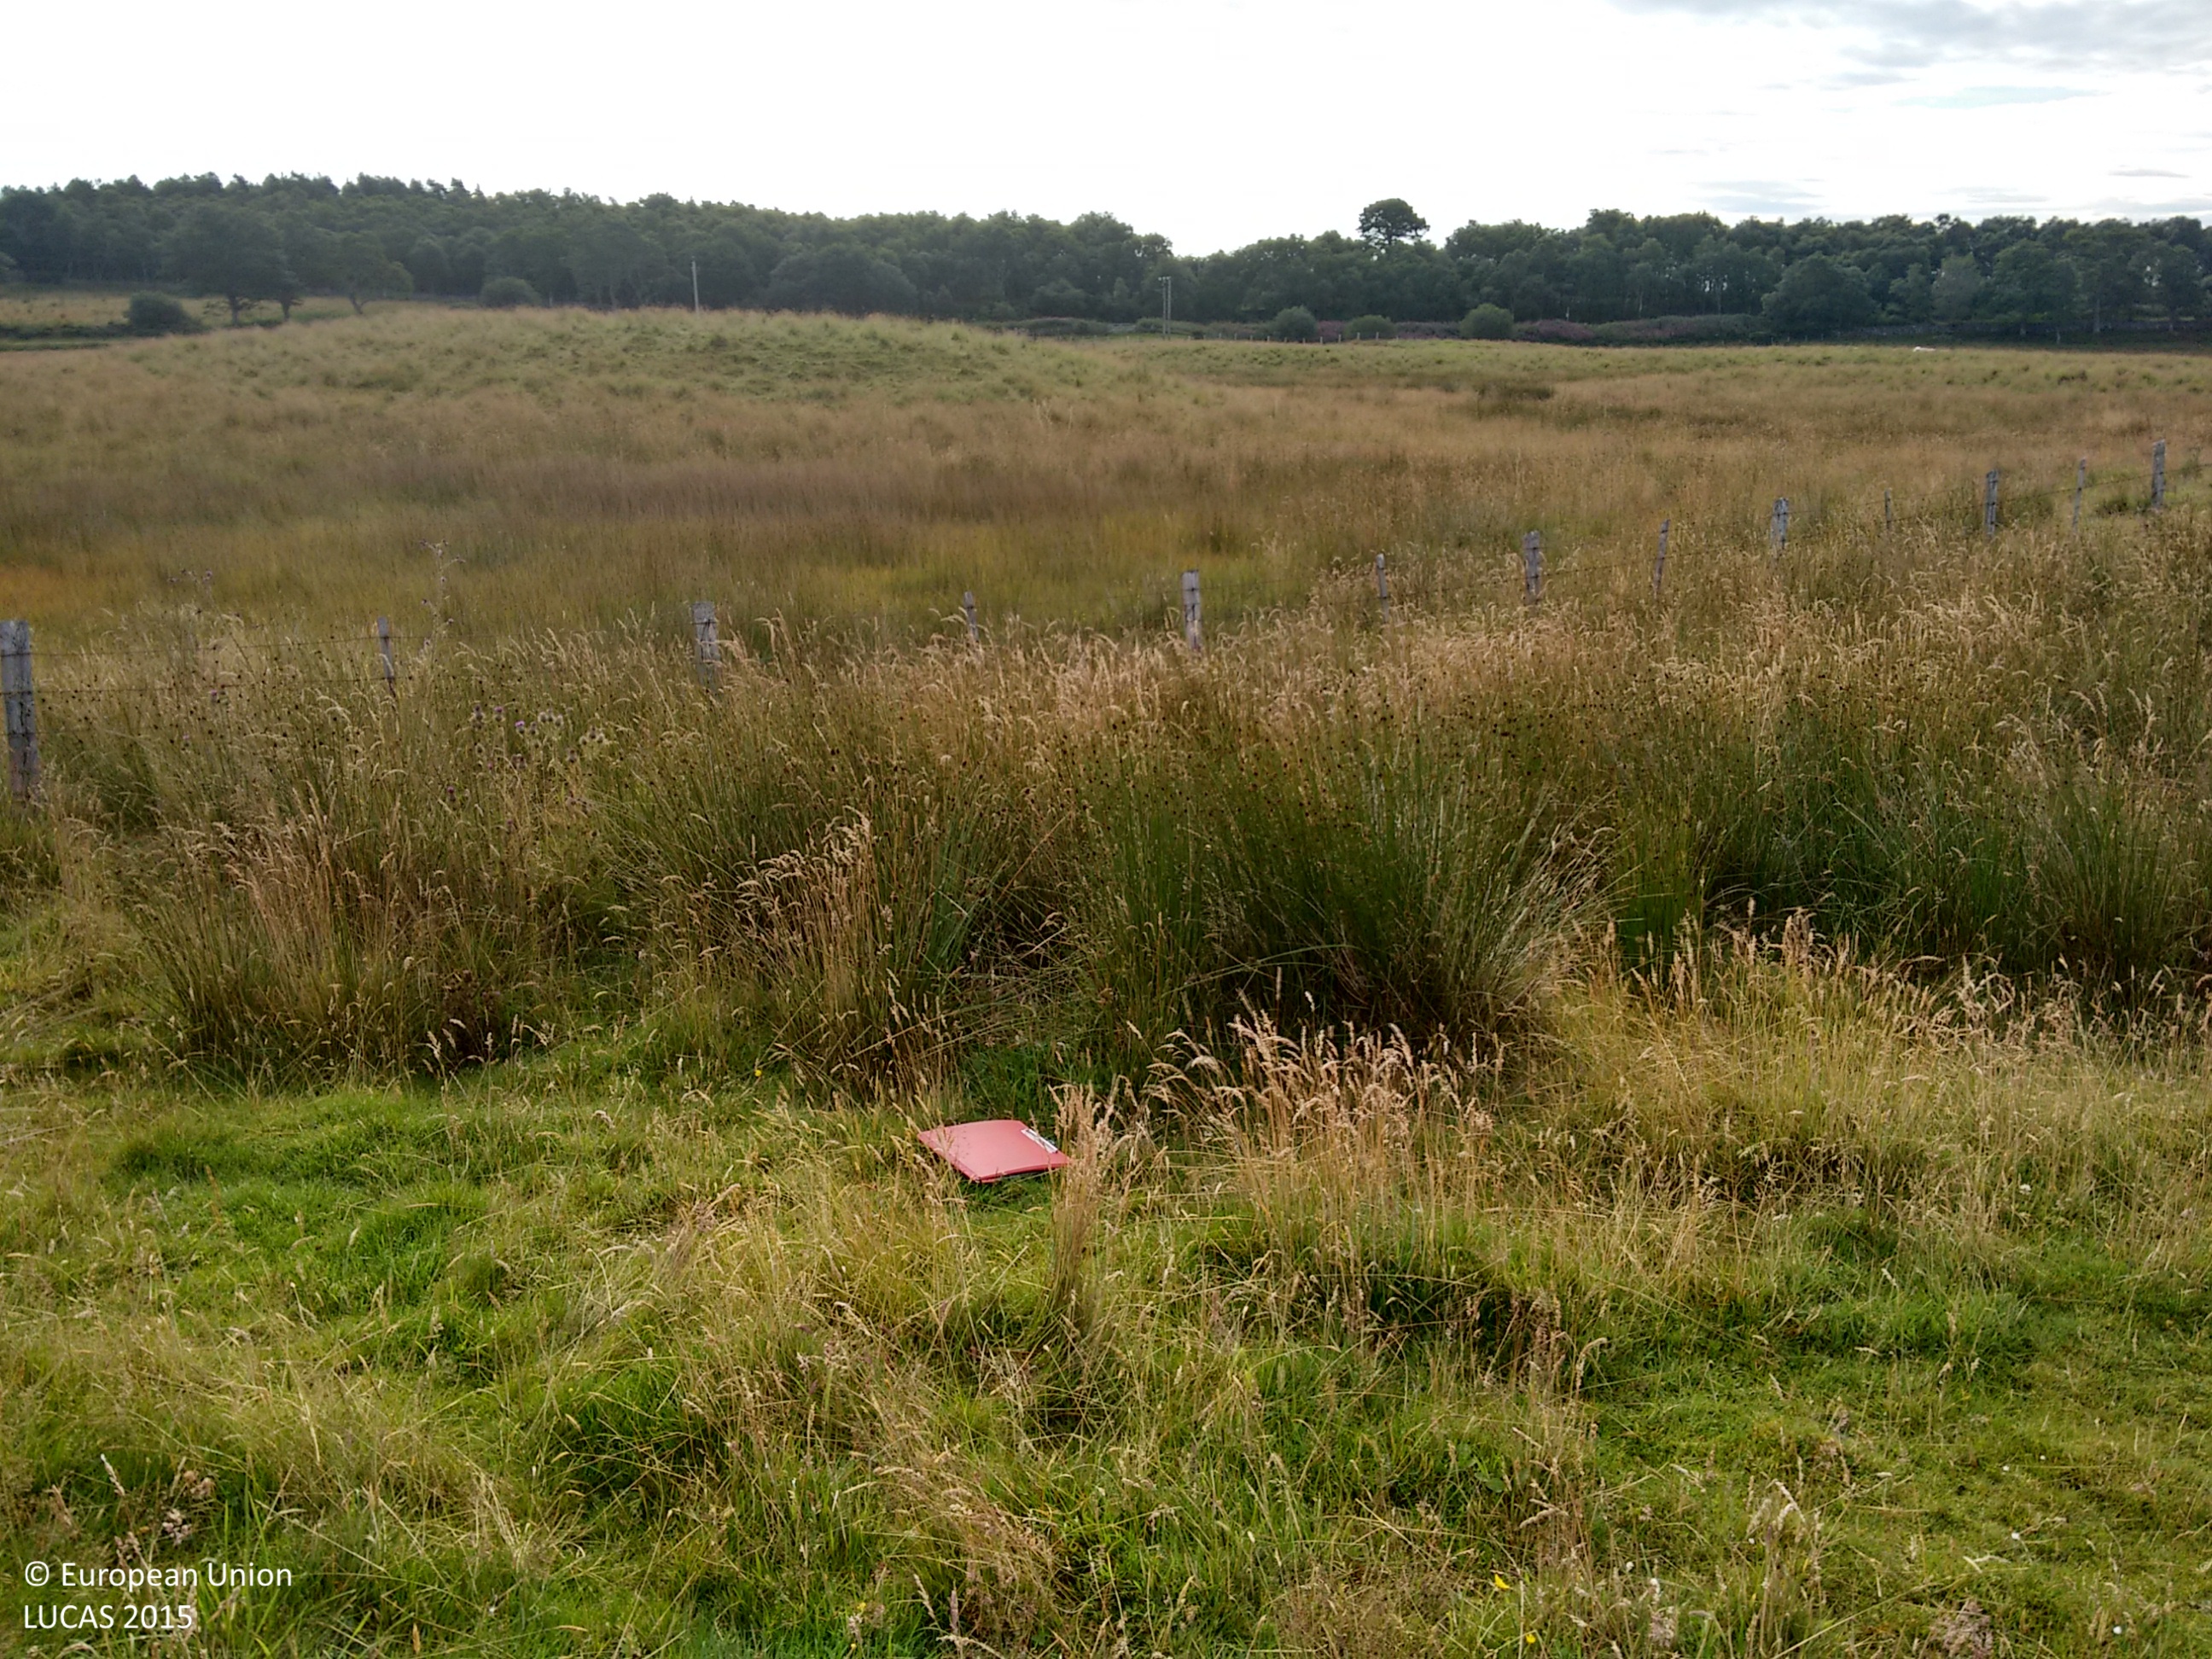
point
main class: Grassland
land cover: Grassland without tree/shrub cover
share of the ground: > 75 %
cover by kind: herbaceous plants 100 %
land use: Agriculture (excluding fallow land and kitchen gardens)
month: August
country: GB
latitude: 57.9308
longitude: -4.0786
